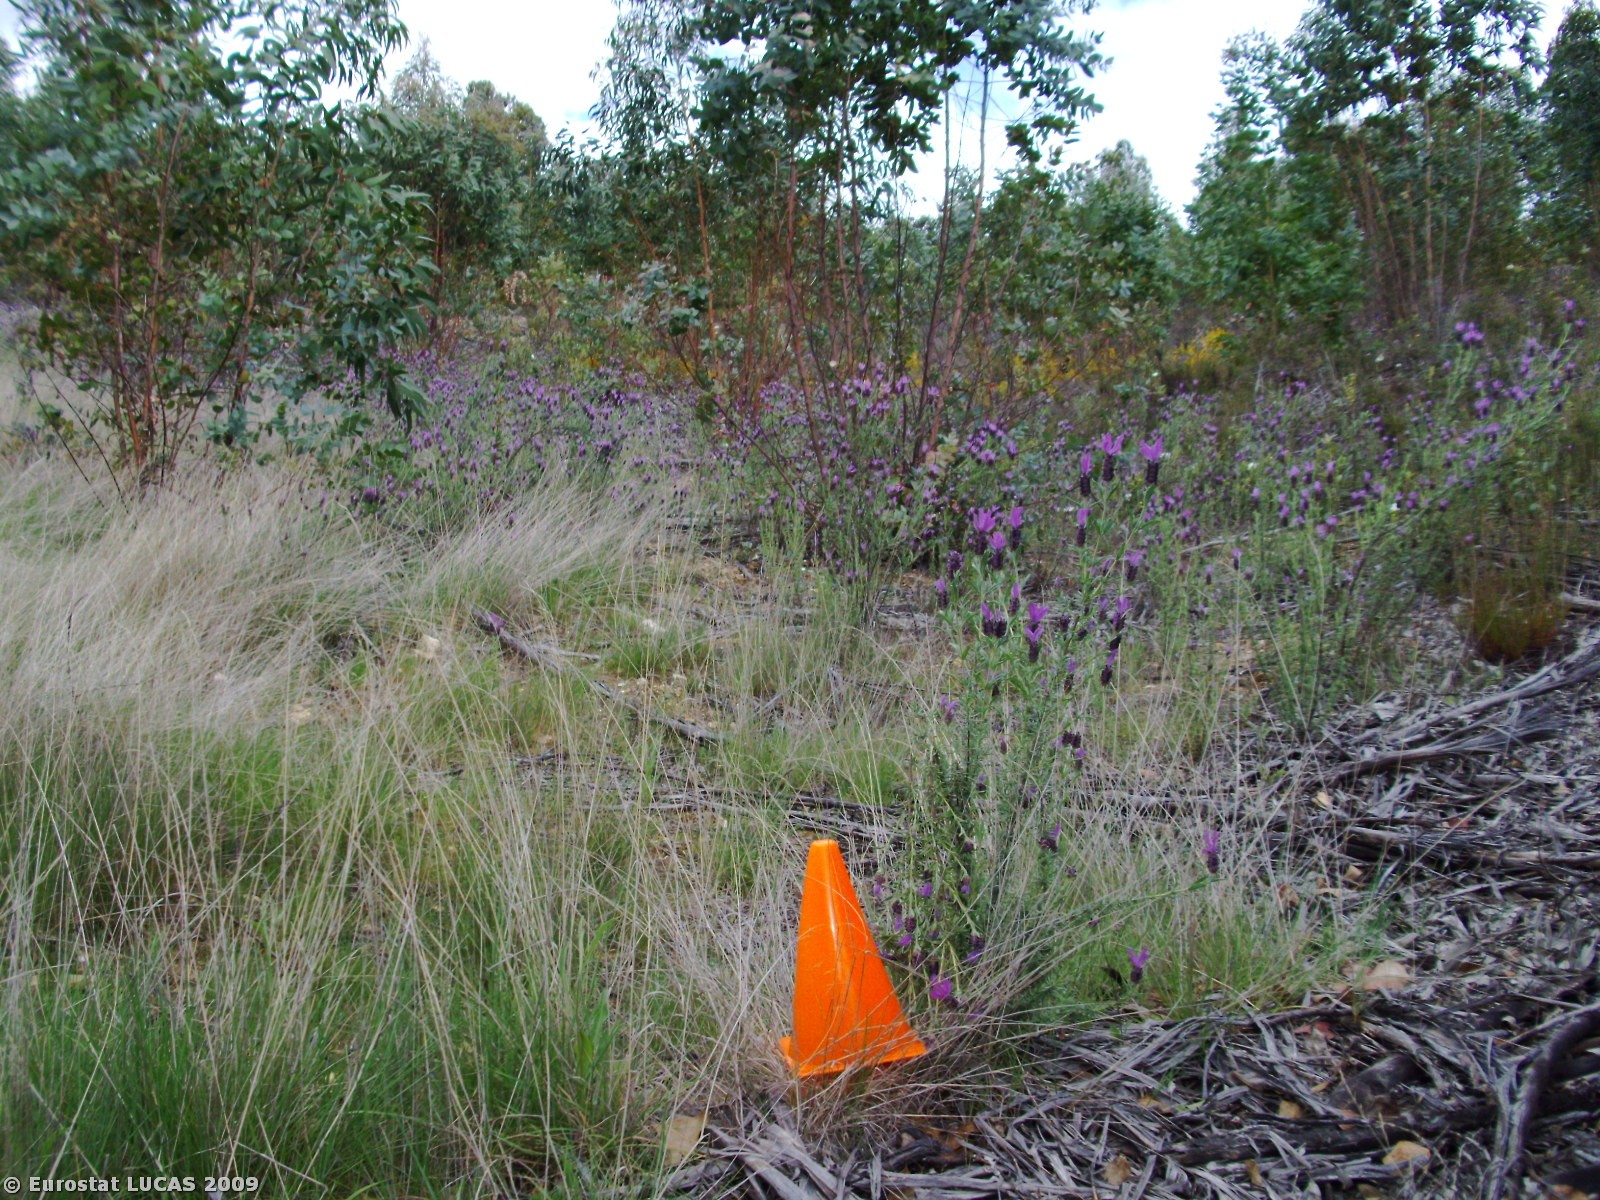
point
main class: Woodland
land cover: Broadleaved woodland
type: plantations and self-sown exotic forest
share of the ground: > 75 %
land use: Forestry
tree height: > 5 m
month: April
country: PT
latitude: 39.7731
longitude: -7.4815
